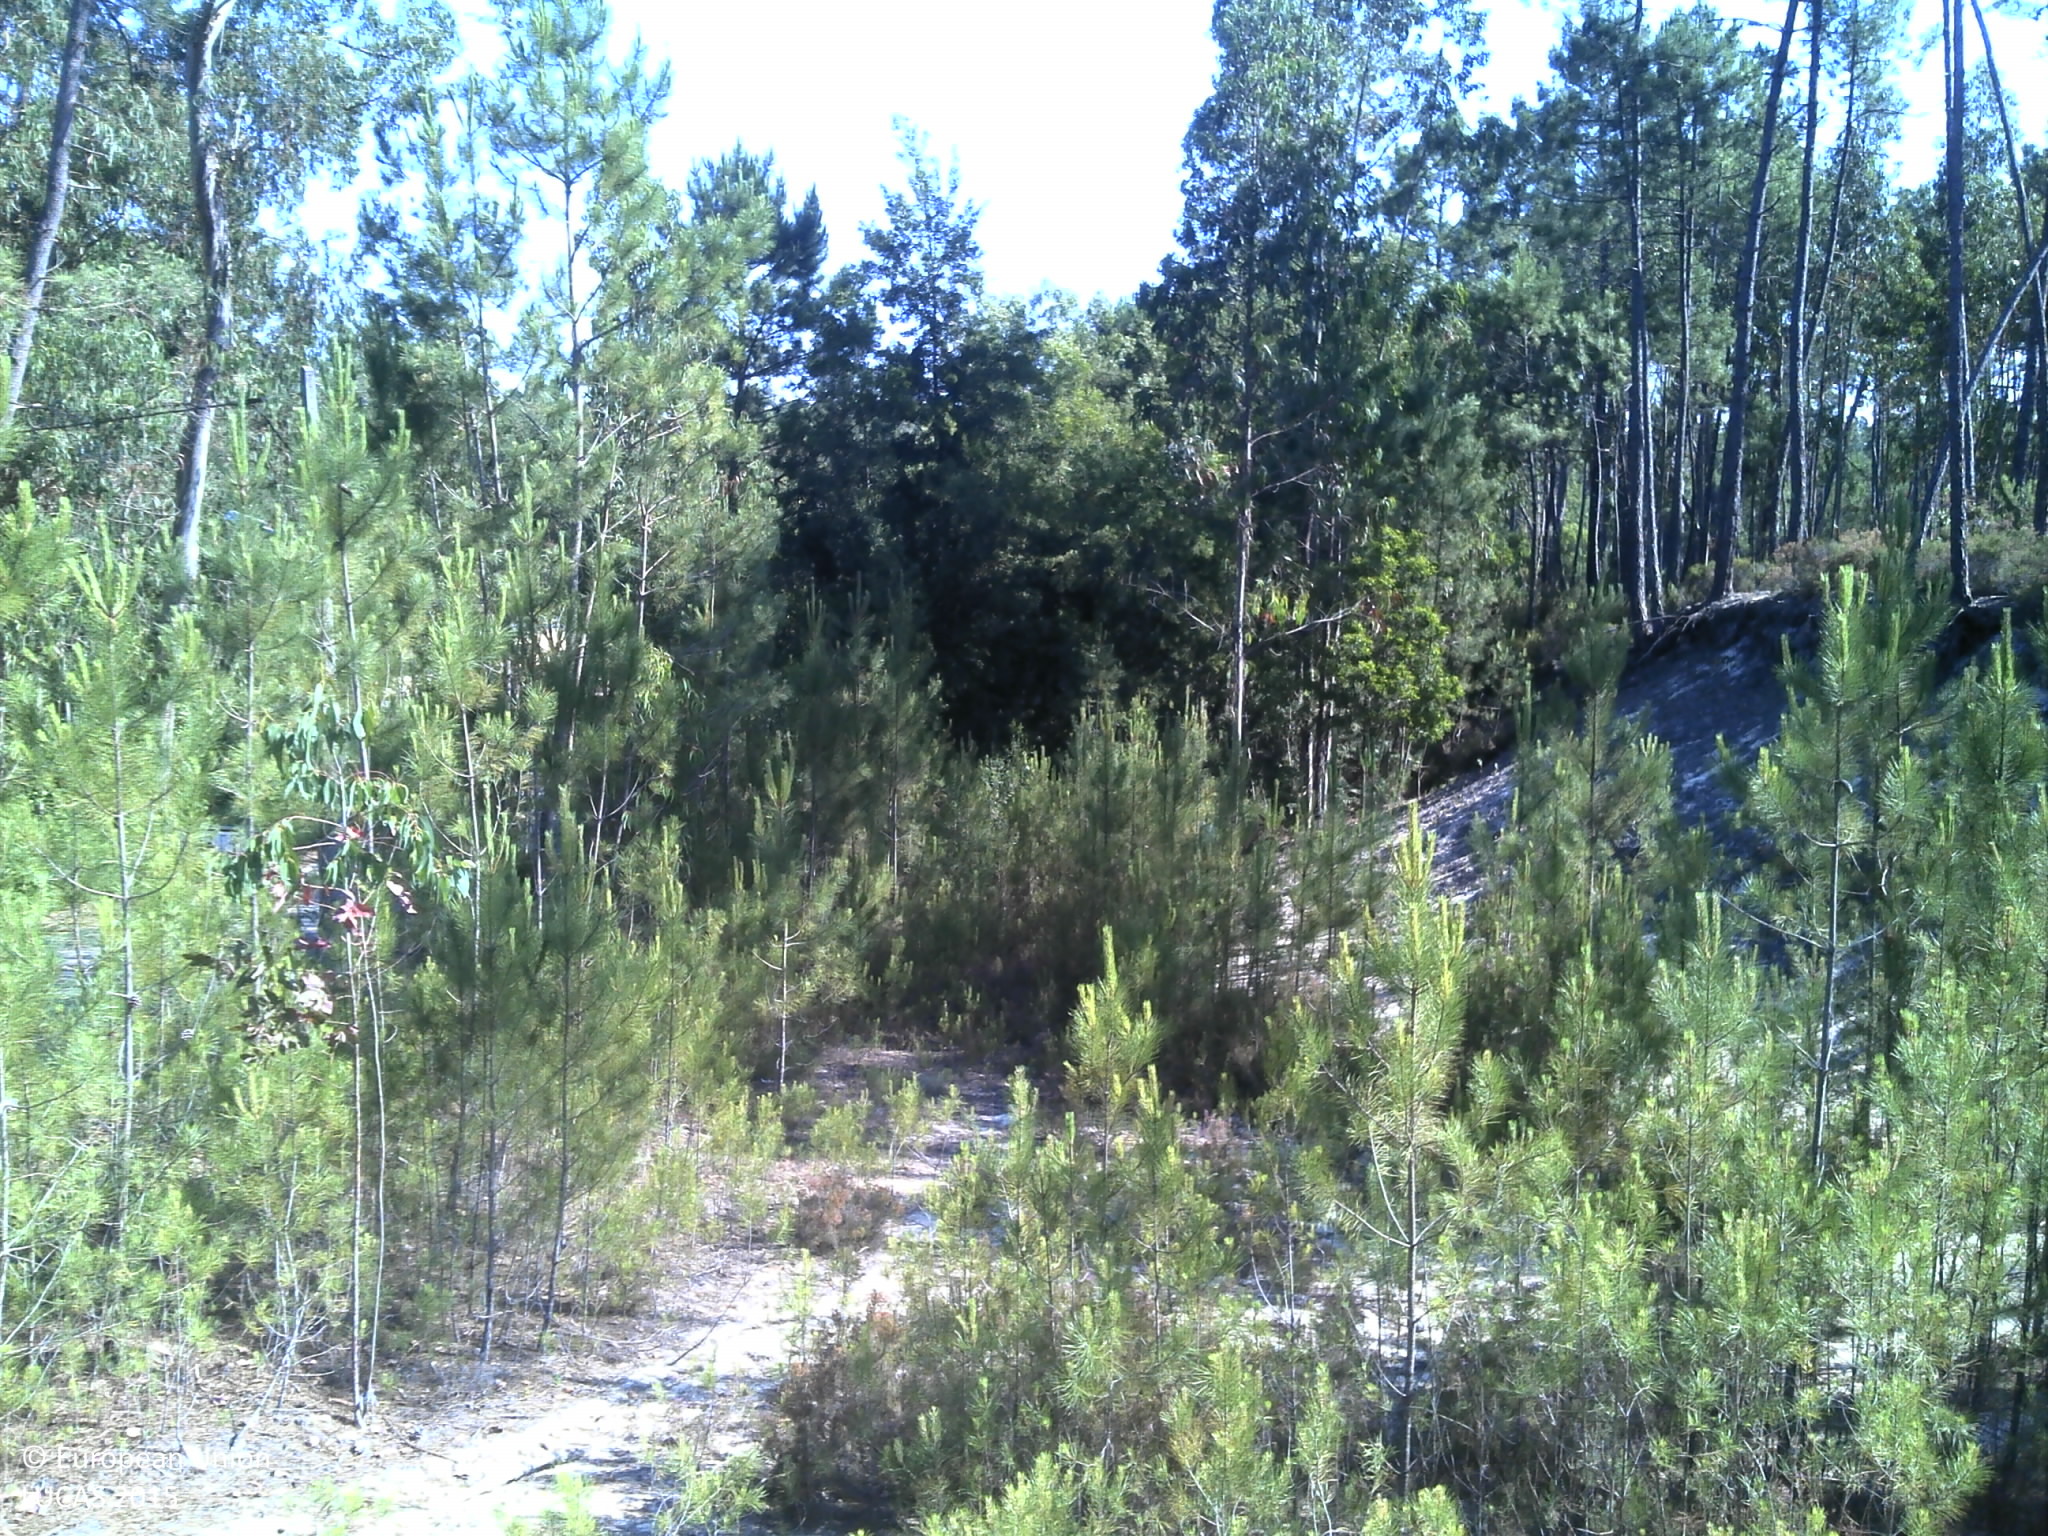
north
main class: Shrubland
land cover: Shrubland without tree cover
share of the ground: 50 - 75 %
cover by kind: shrubs 70 %, unconsolidated bare surface 25 %, herbaceous plants 5 %
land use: Forestry
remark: Clear cut
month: June
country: PT
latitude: 40.3775
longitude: -8.6922
